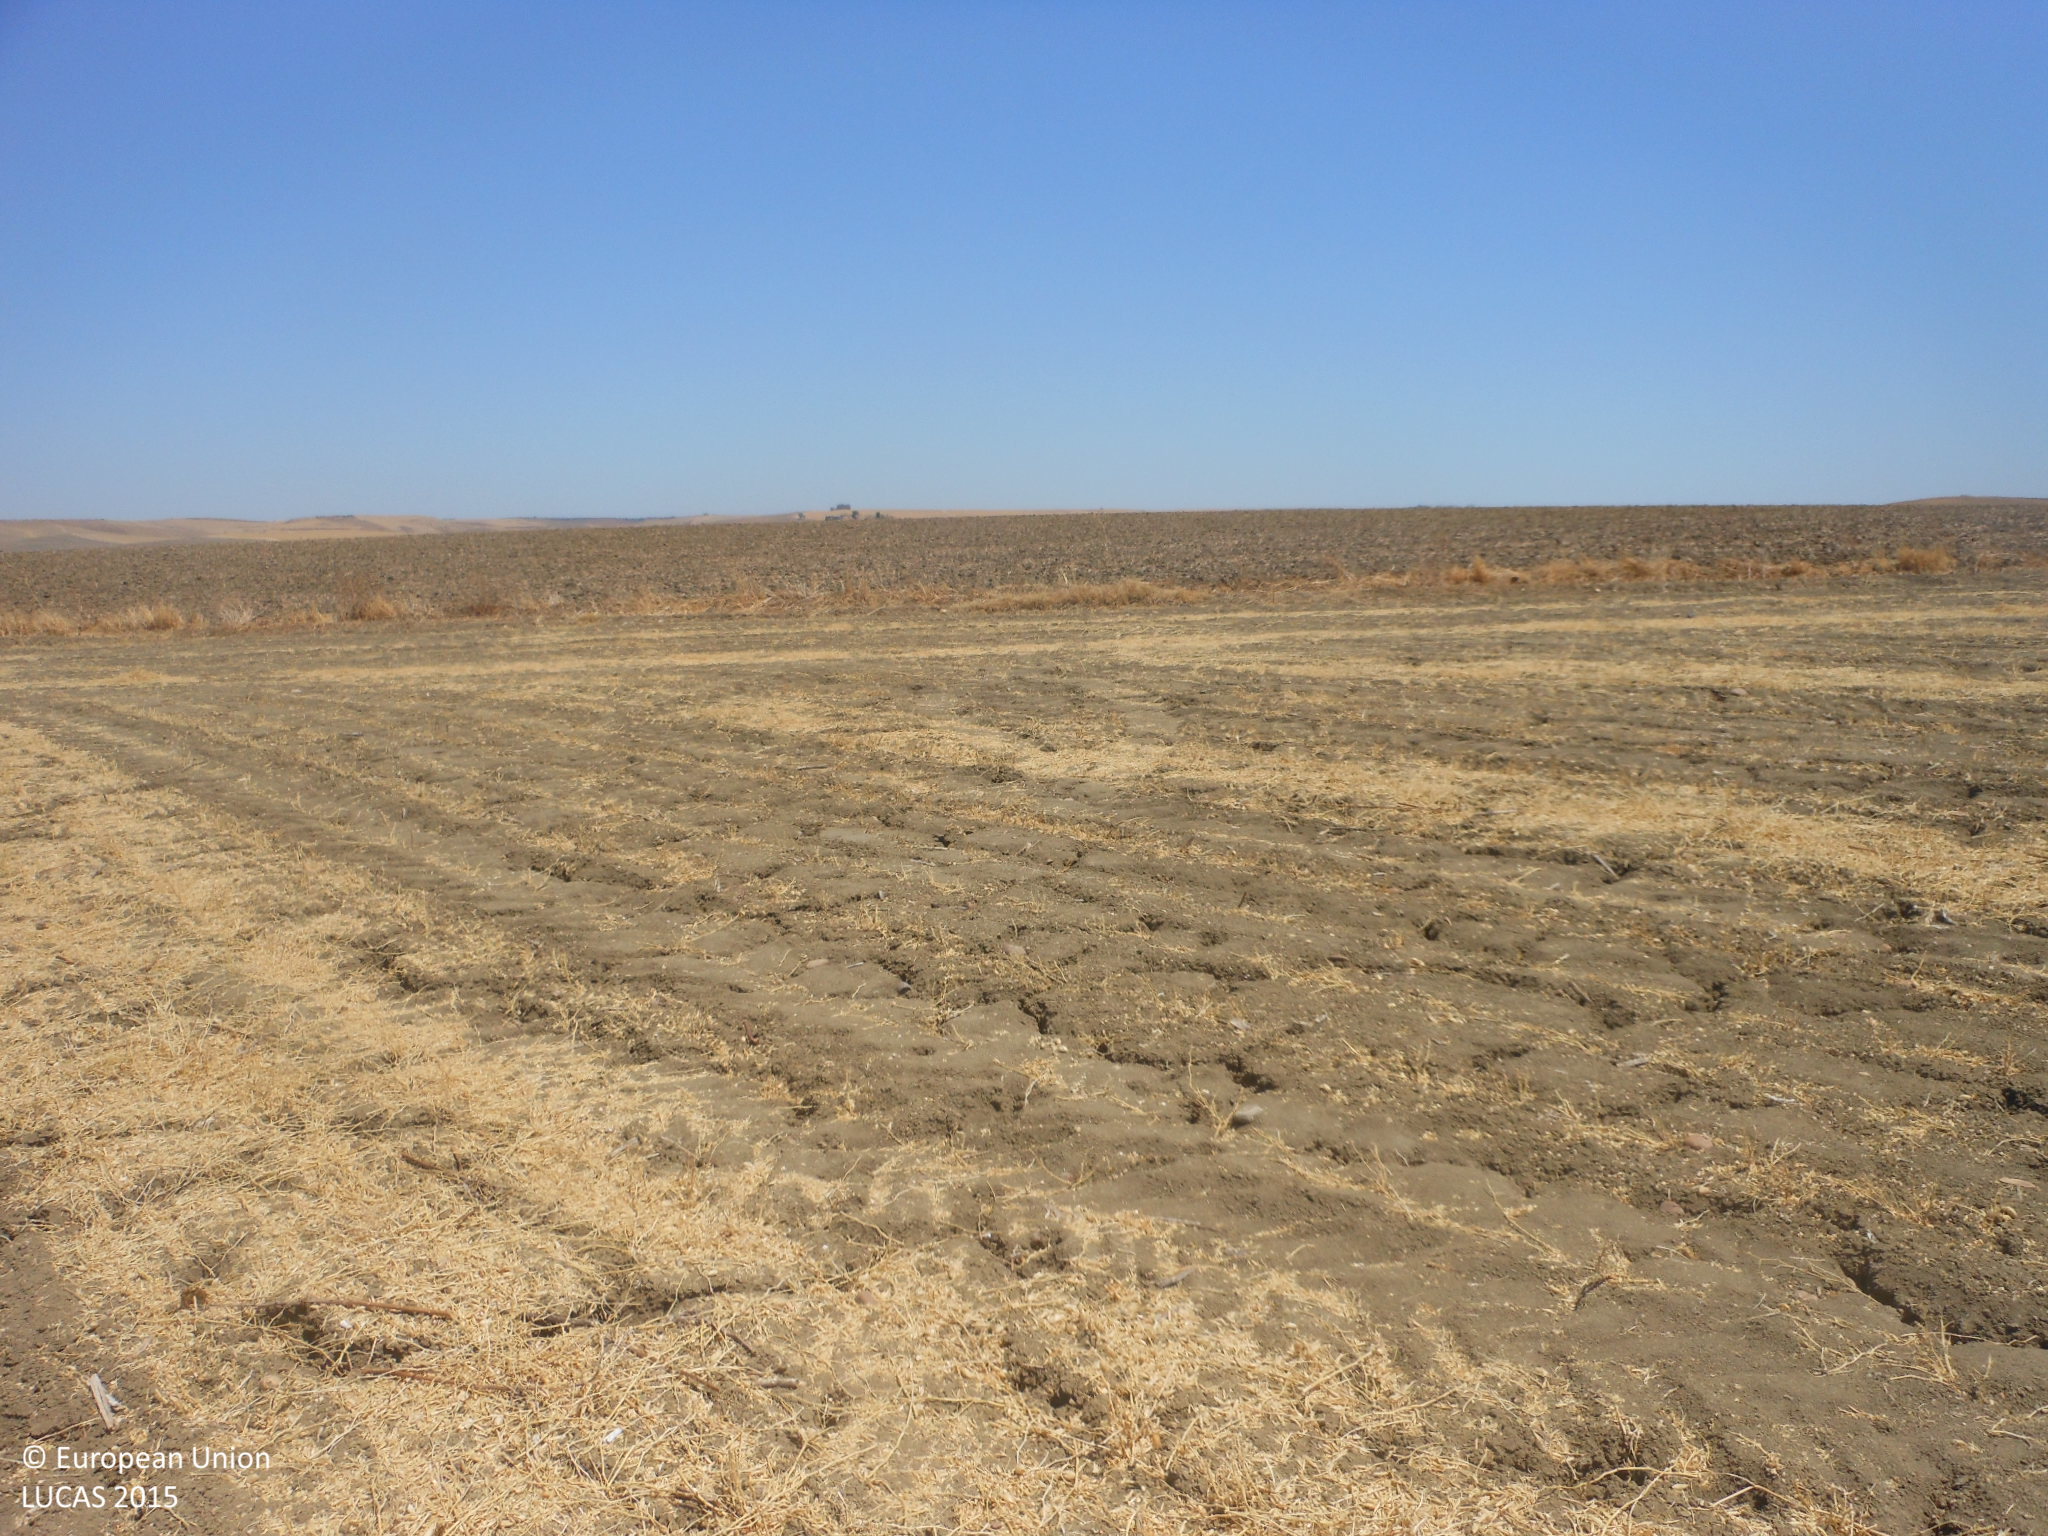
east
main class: Cropland
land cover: Dry pulses
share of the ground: < 10 %
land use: Agriculture (excluding fallow land and kitchen gardens)
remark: Harvested field
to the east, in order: Dry pulses; Grass margins; Tracks; Grass margins; Dry pulses
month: July
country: ES
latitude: 37.5201
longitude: -5.6000
